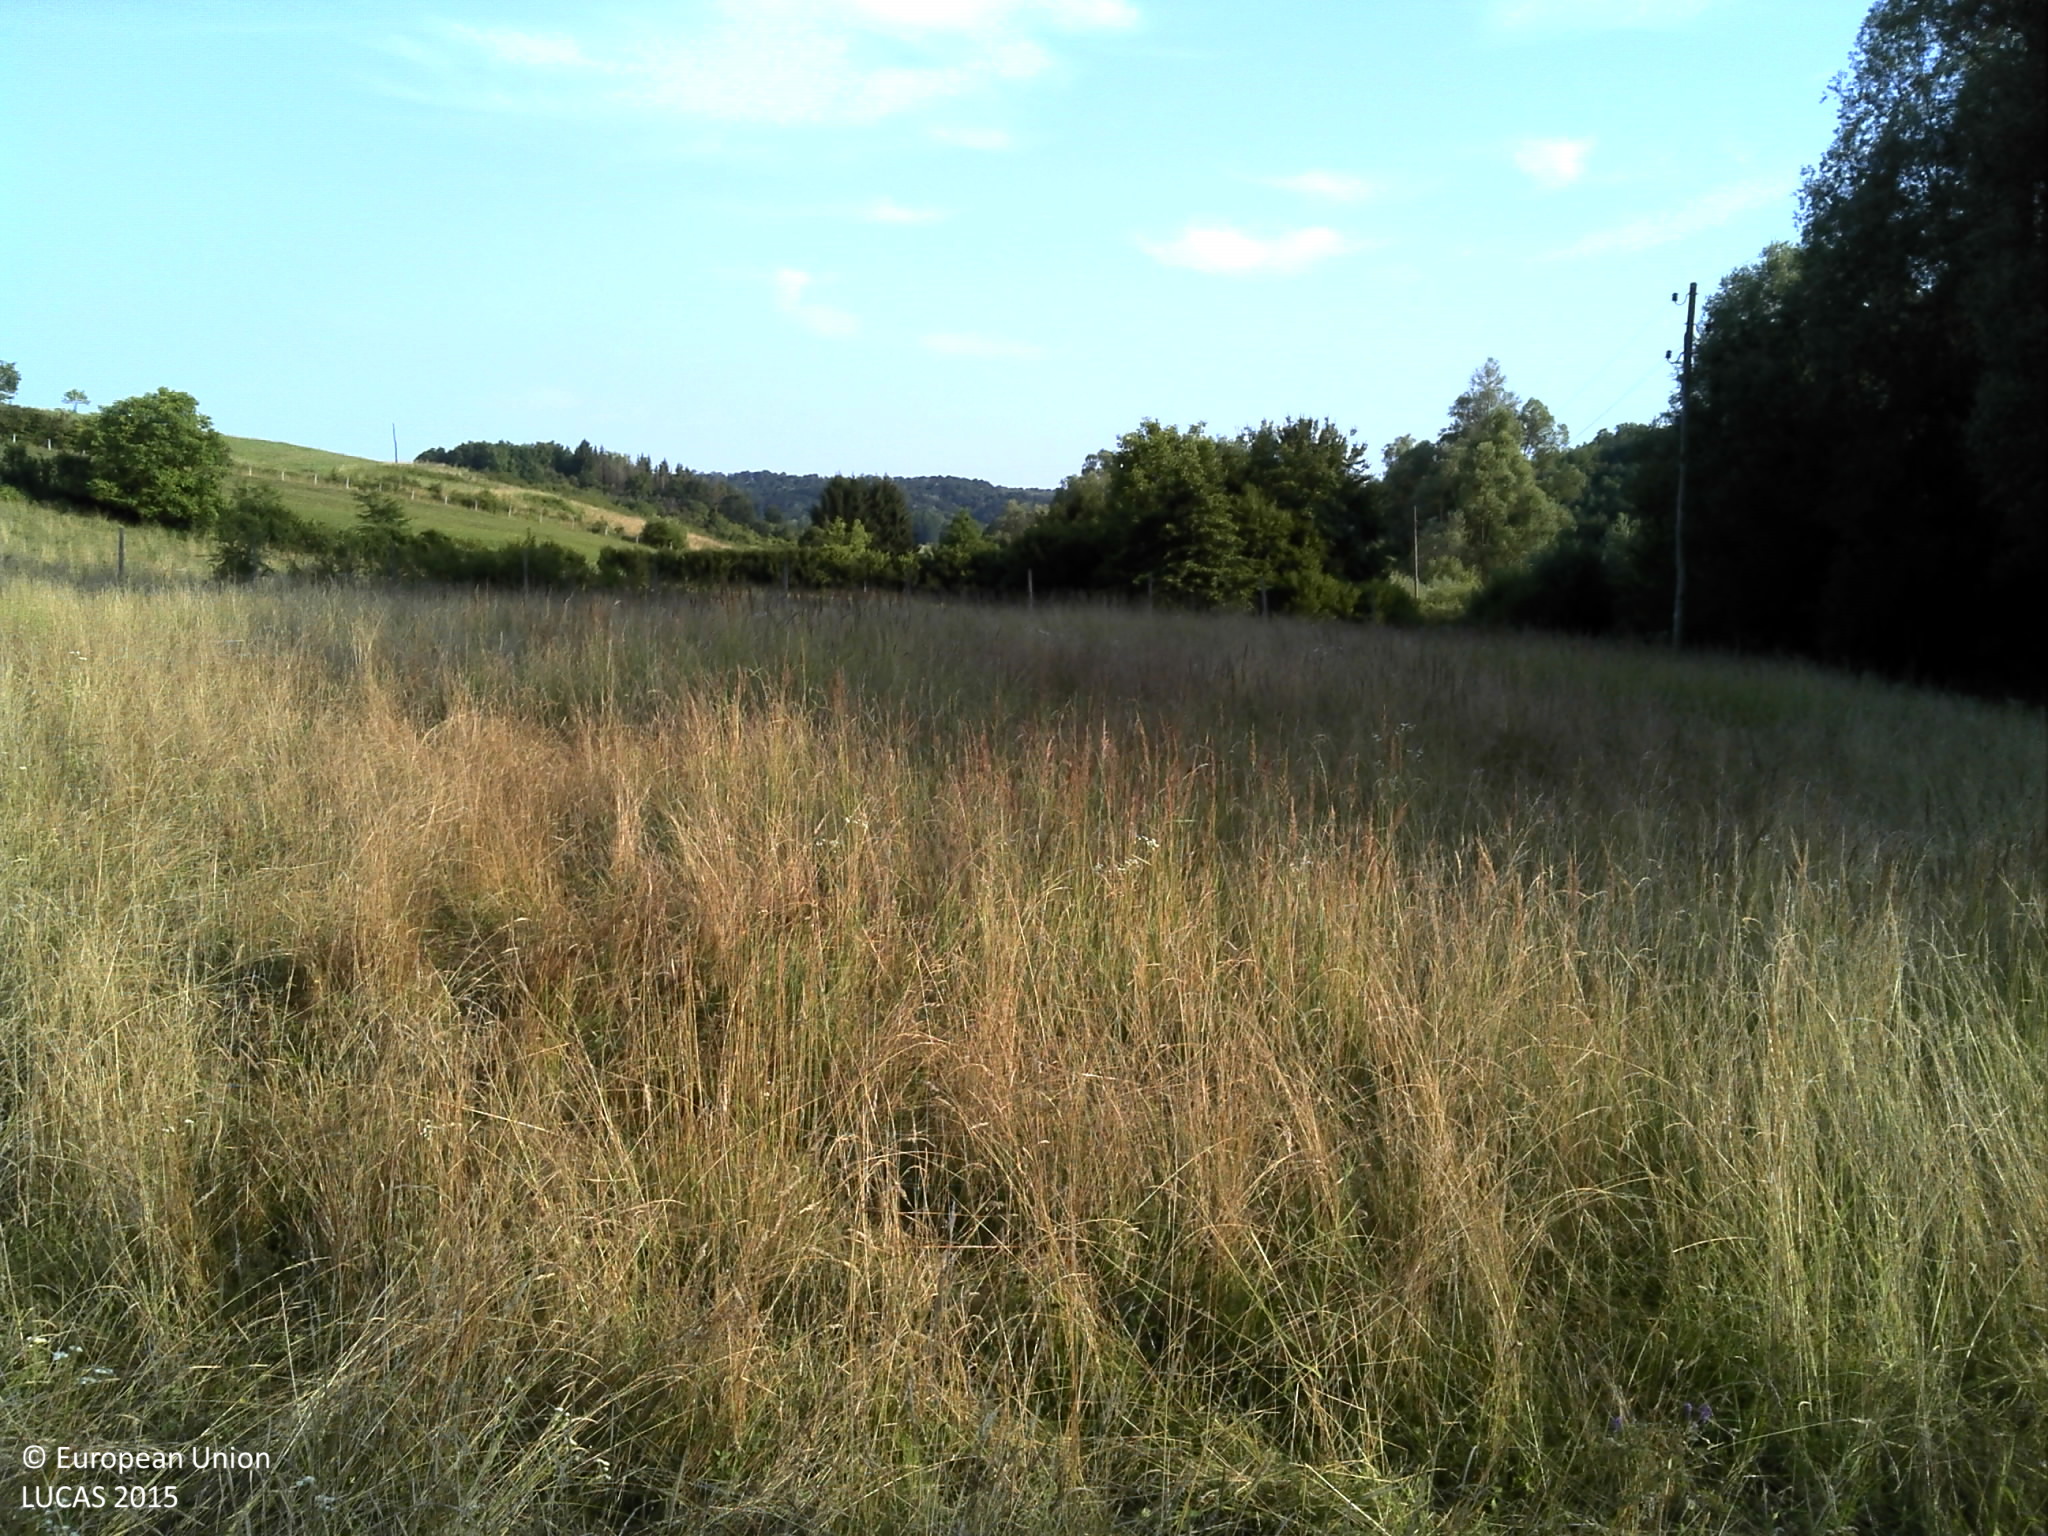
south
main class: Grassland
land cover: Grassland without tree/shrub cover
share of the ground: > 75 %
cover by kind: herbaceous plants 100 %
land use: Semi-natural and natural areas not in use
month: July
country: HR
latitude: 45.5431
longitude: 16.7229
